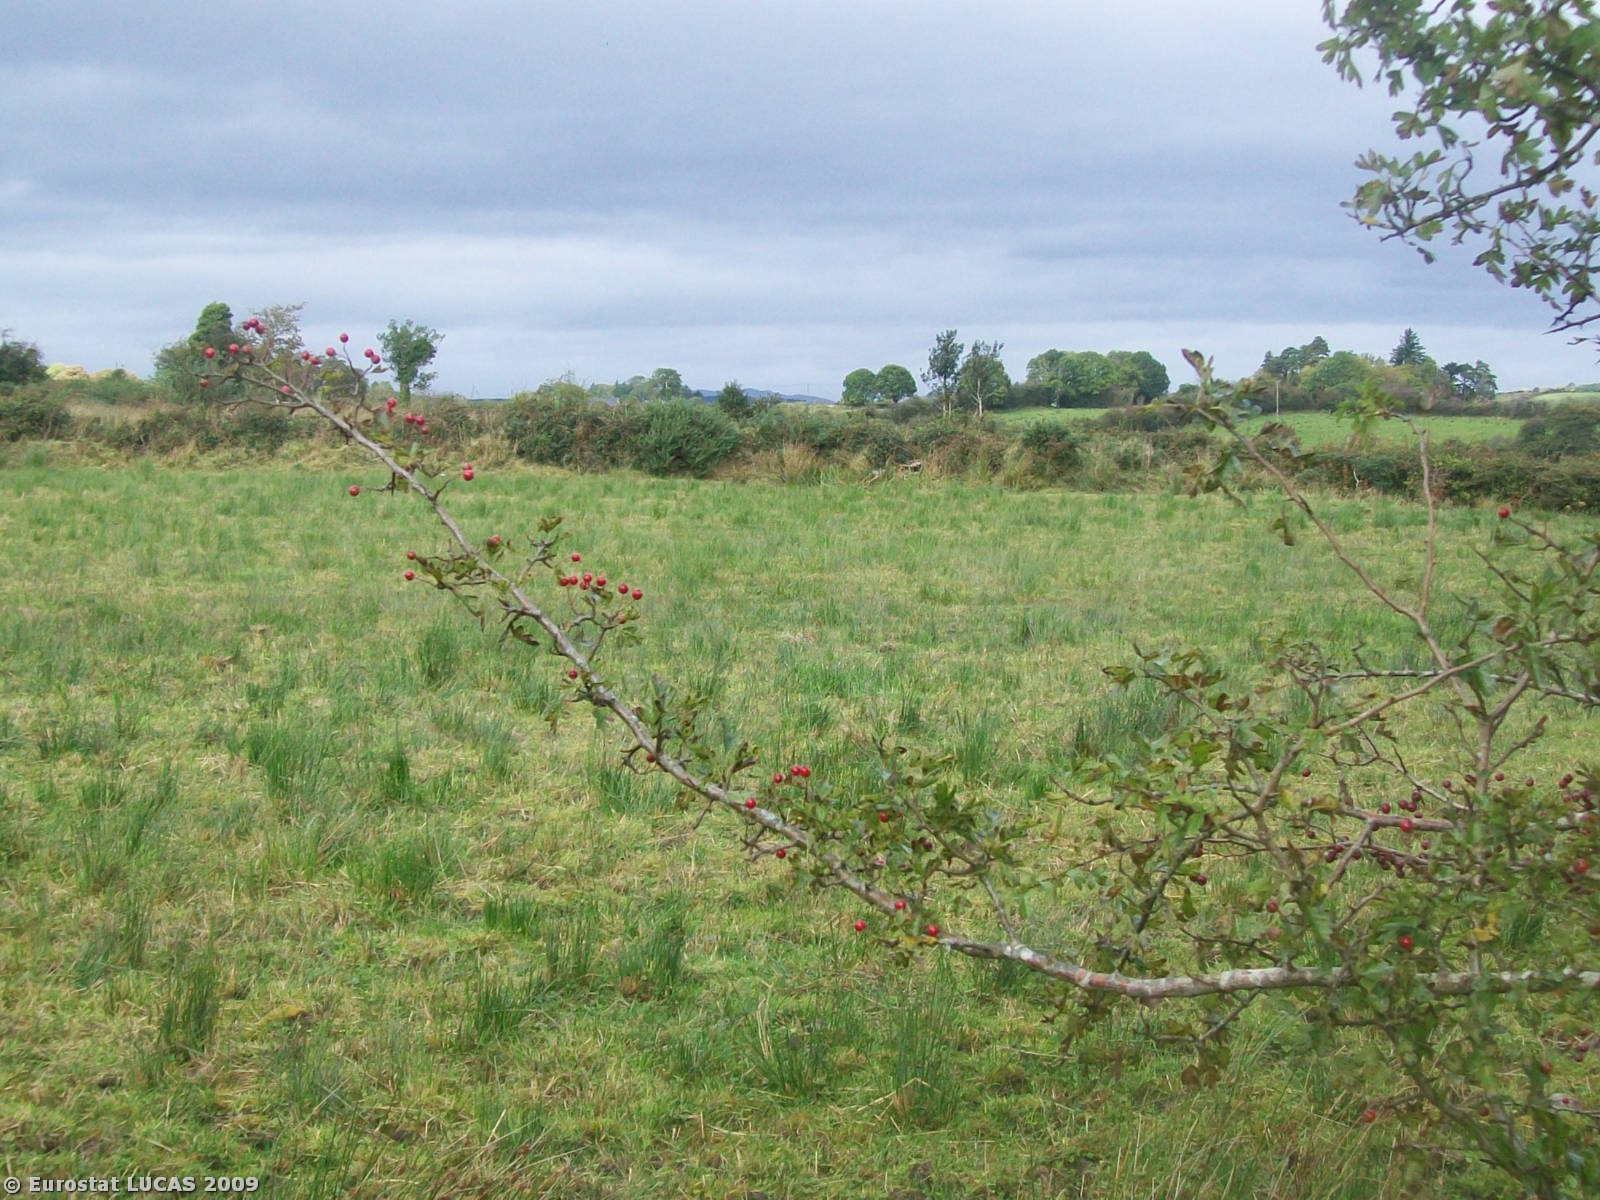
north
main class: Grassland
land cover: Grassland without tree/shrub cover
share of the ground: > 75 %
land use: Agriculture (excluding fallow land and kitchen gardens)
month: September
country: IE
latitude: 54.0859
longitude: -8.3635
